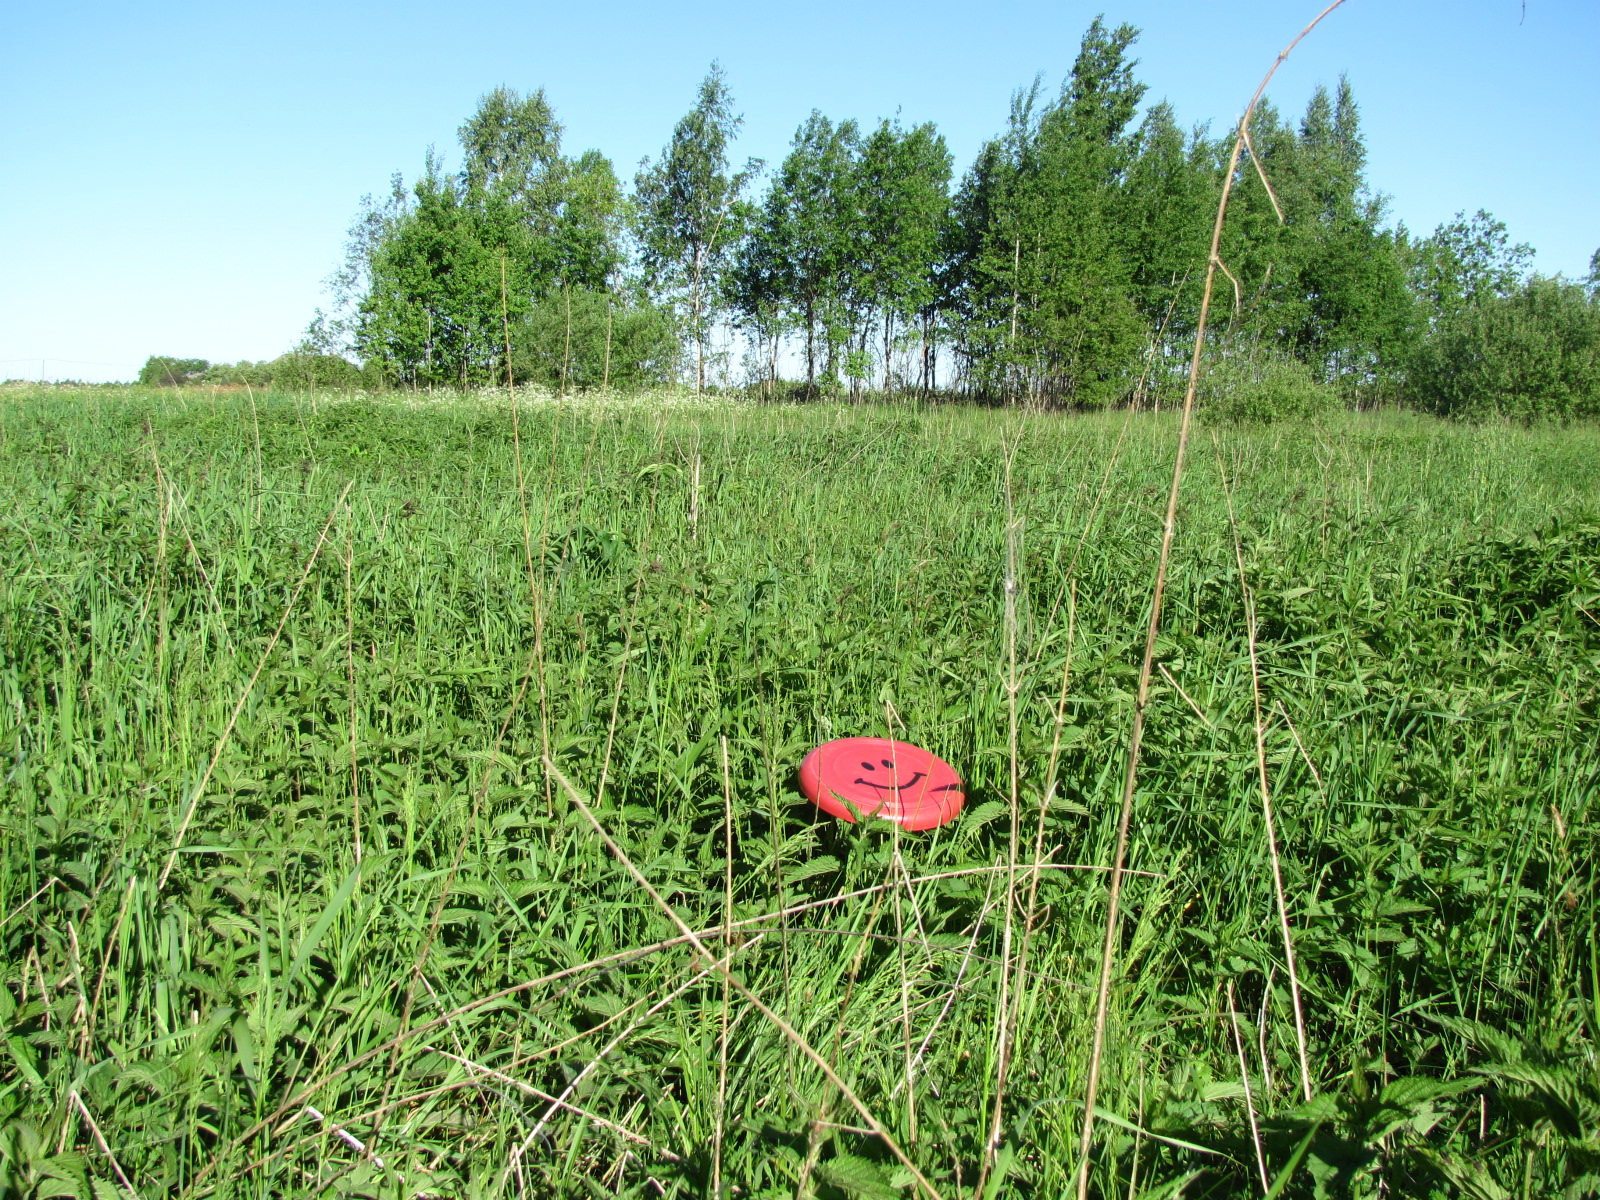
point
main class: Grassland
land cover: Spontaneously vegetated surfaces
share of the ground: > 75 %
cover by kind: herbaceous plants 100 %
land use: Fallow land
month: June
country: LV
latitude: 56.5564
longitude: 24.2612
